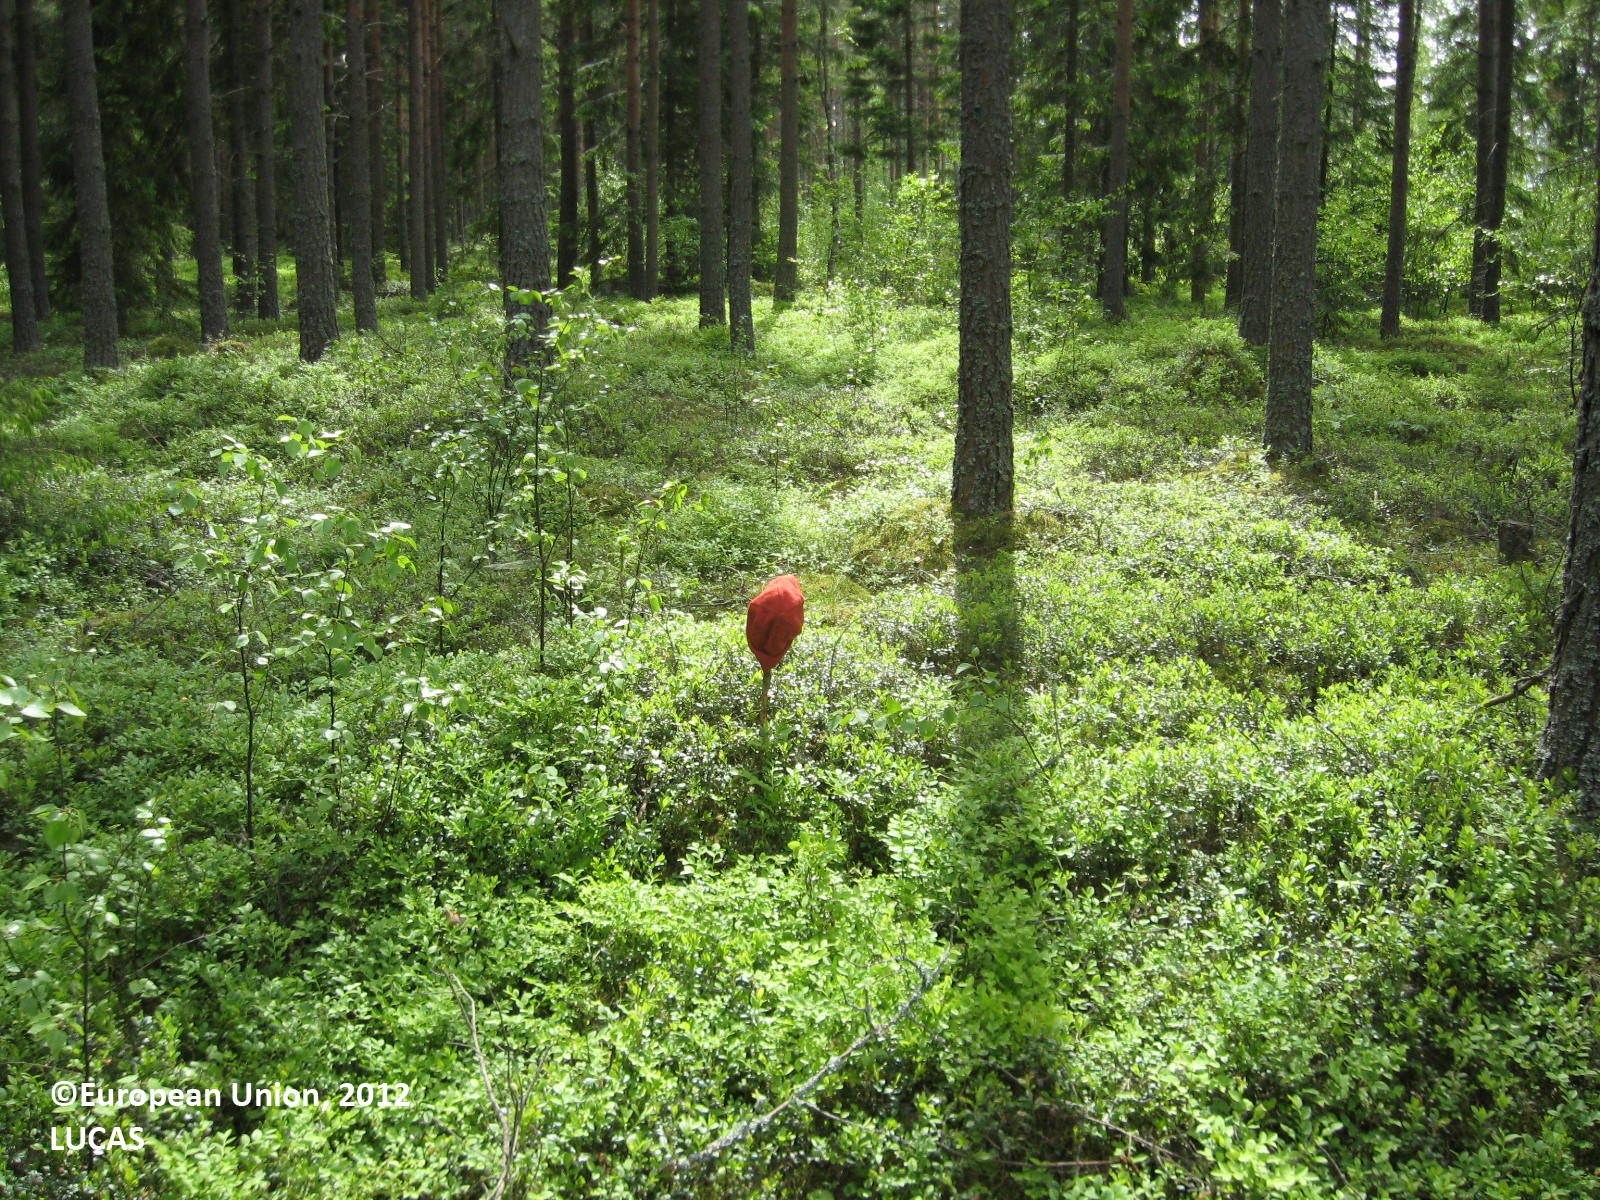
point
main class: Woodland
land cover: Other coniferous woodland
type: boreal forest
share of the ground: > 75 %
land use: Forestry
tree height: > 5 m
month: June
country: FI
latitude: 62.6388
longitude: 21.0965
